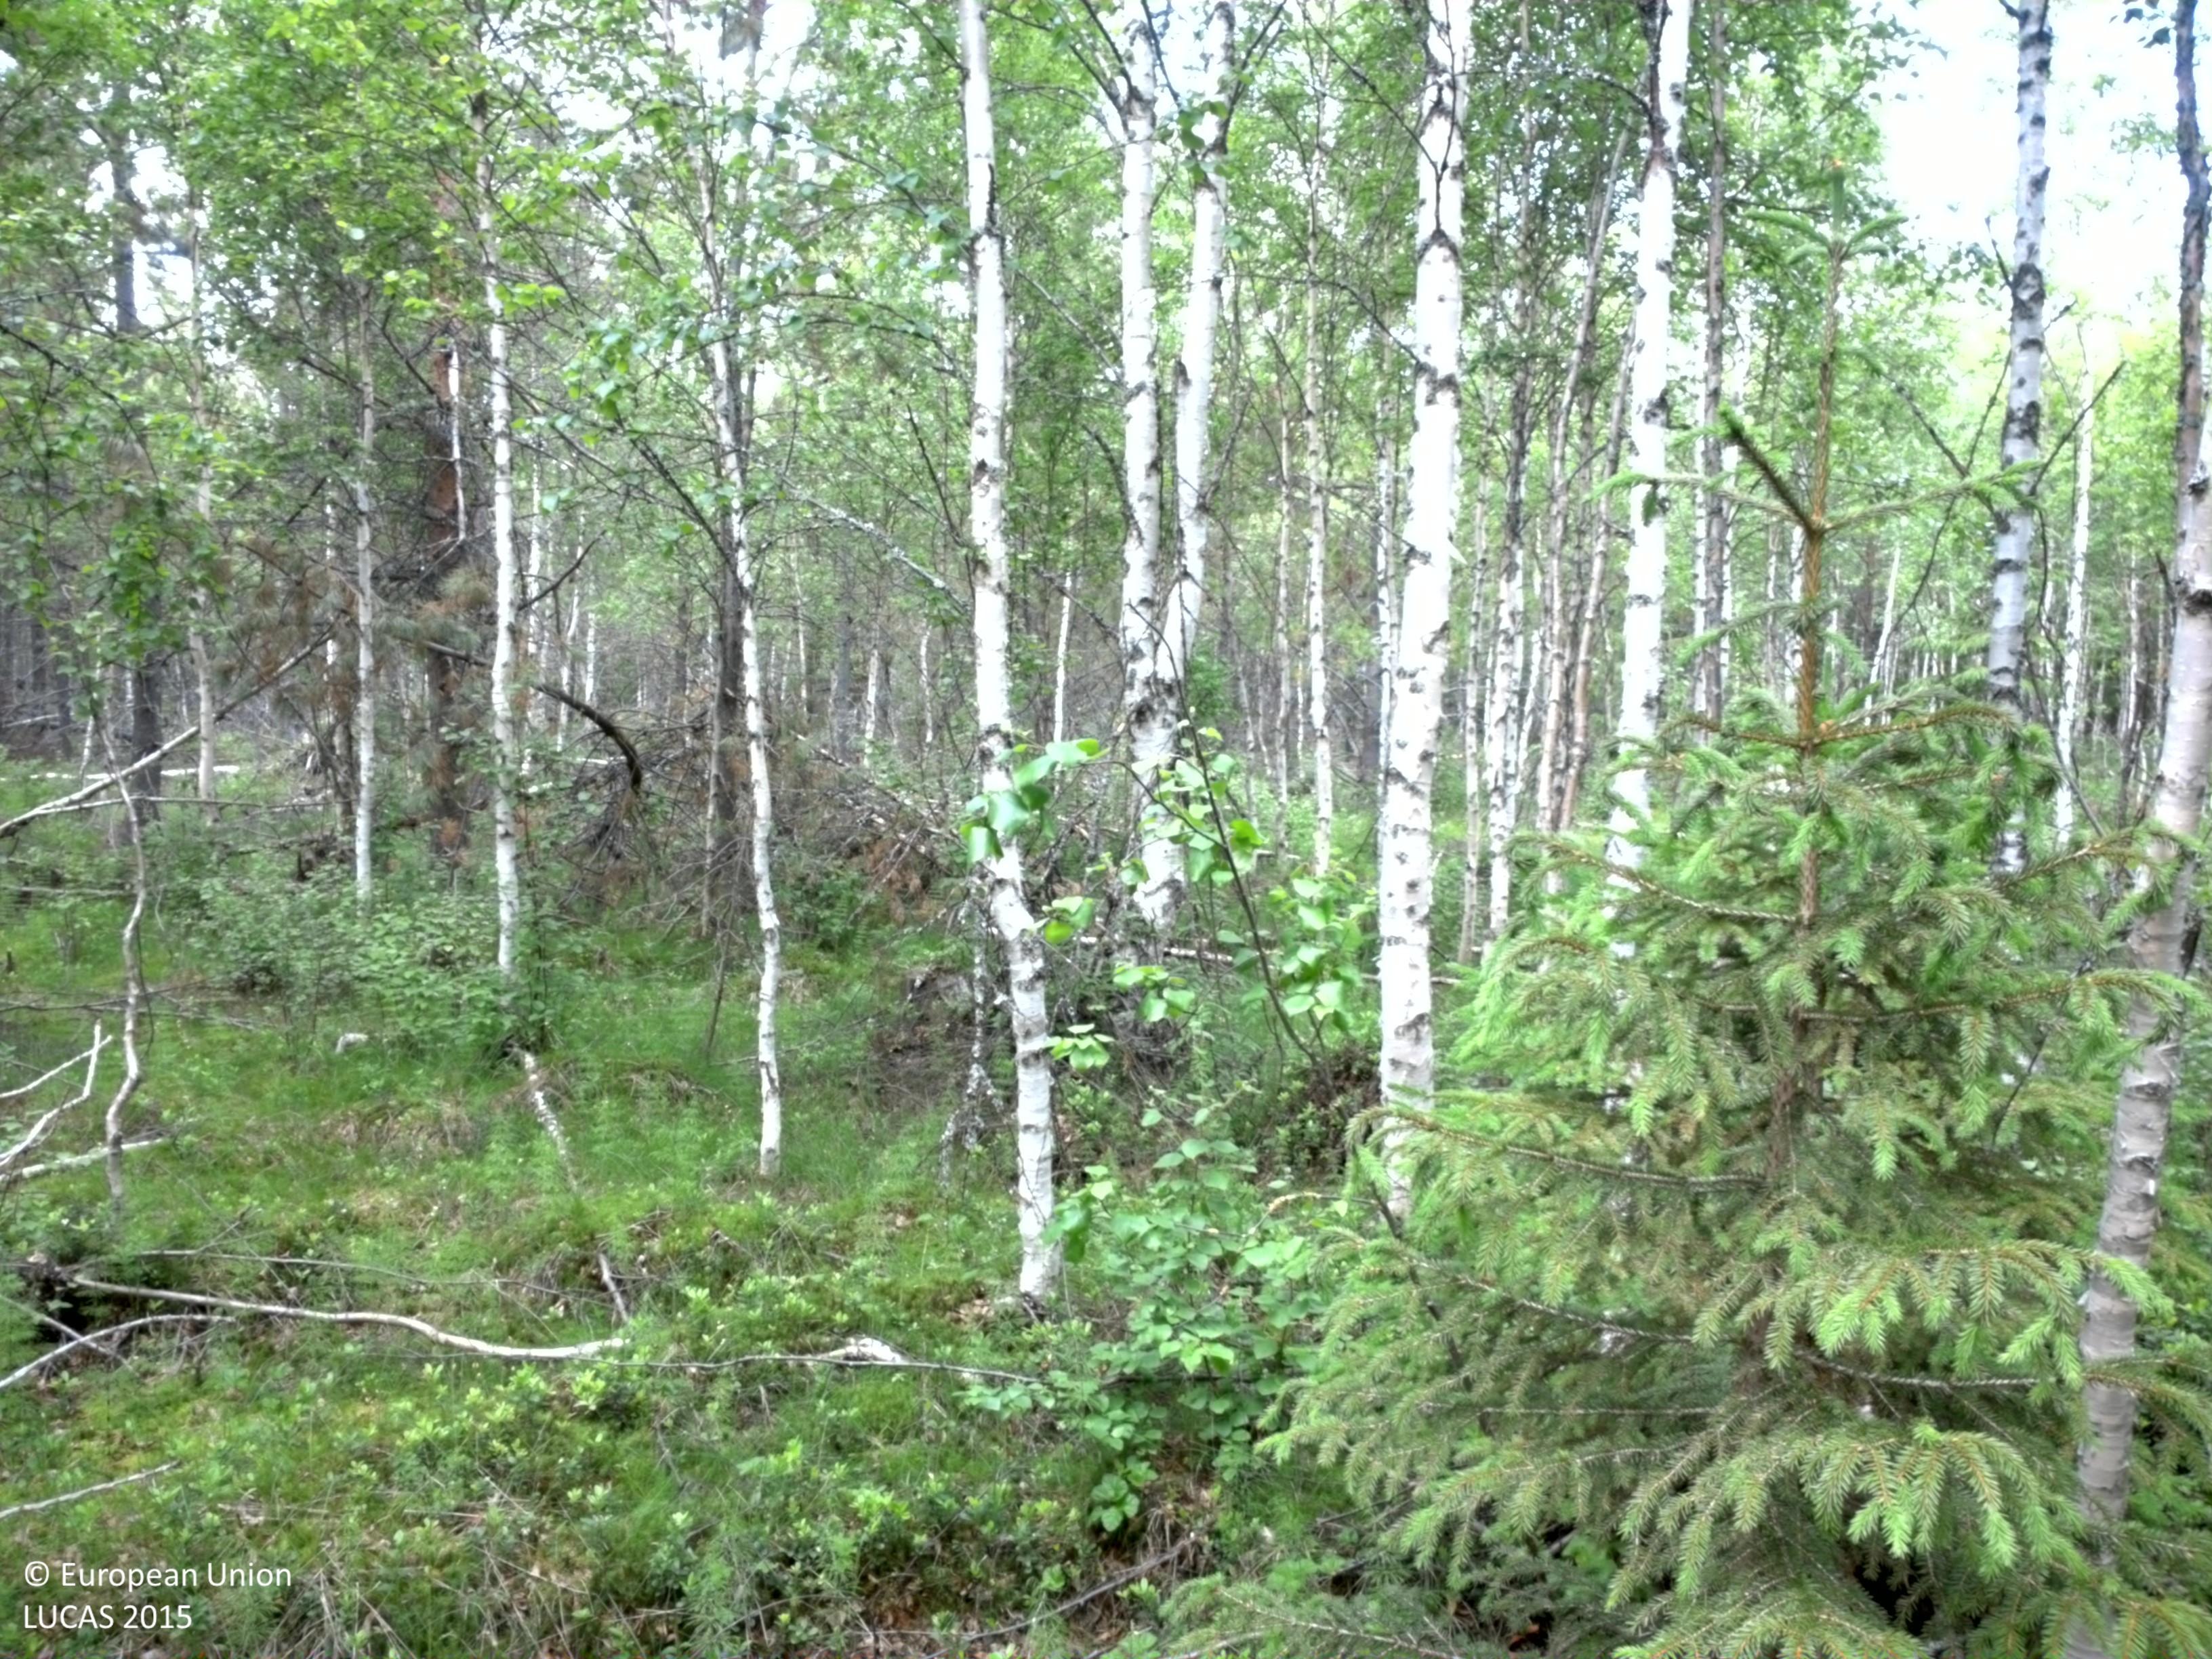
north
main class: Woodland
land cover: Other mixed woodland
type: boreal forest
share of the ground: 50 - 75 %
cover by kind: coniferous forest trees 45 %, broadleaved forest trees 25 %, shrubs 15 %, herbaceous plants 15 %
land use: Forestry
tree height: > 5 m
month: July
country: SE
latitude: 64.4756
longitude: 20.9422
